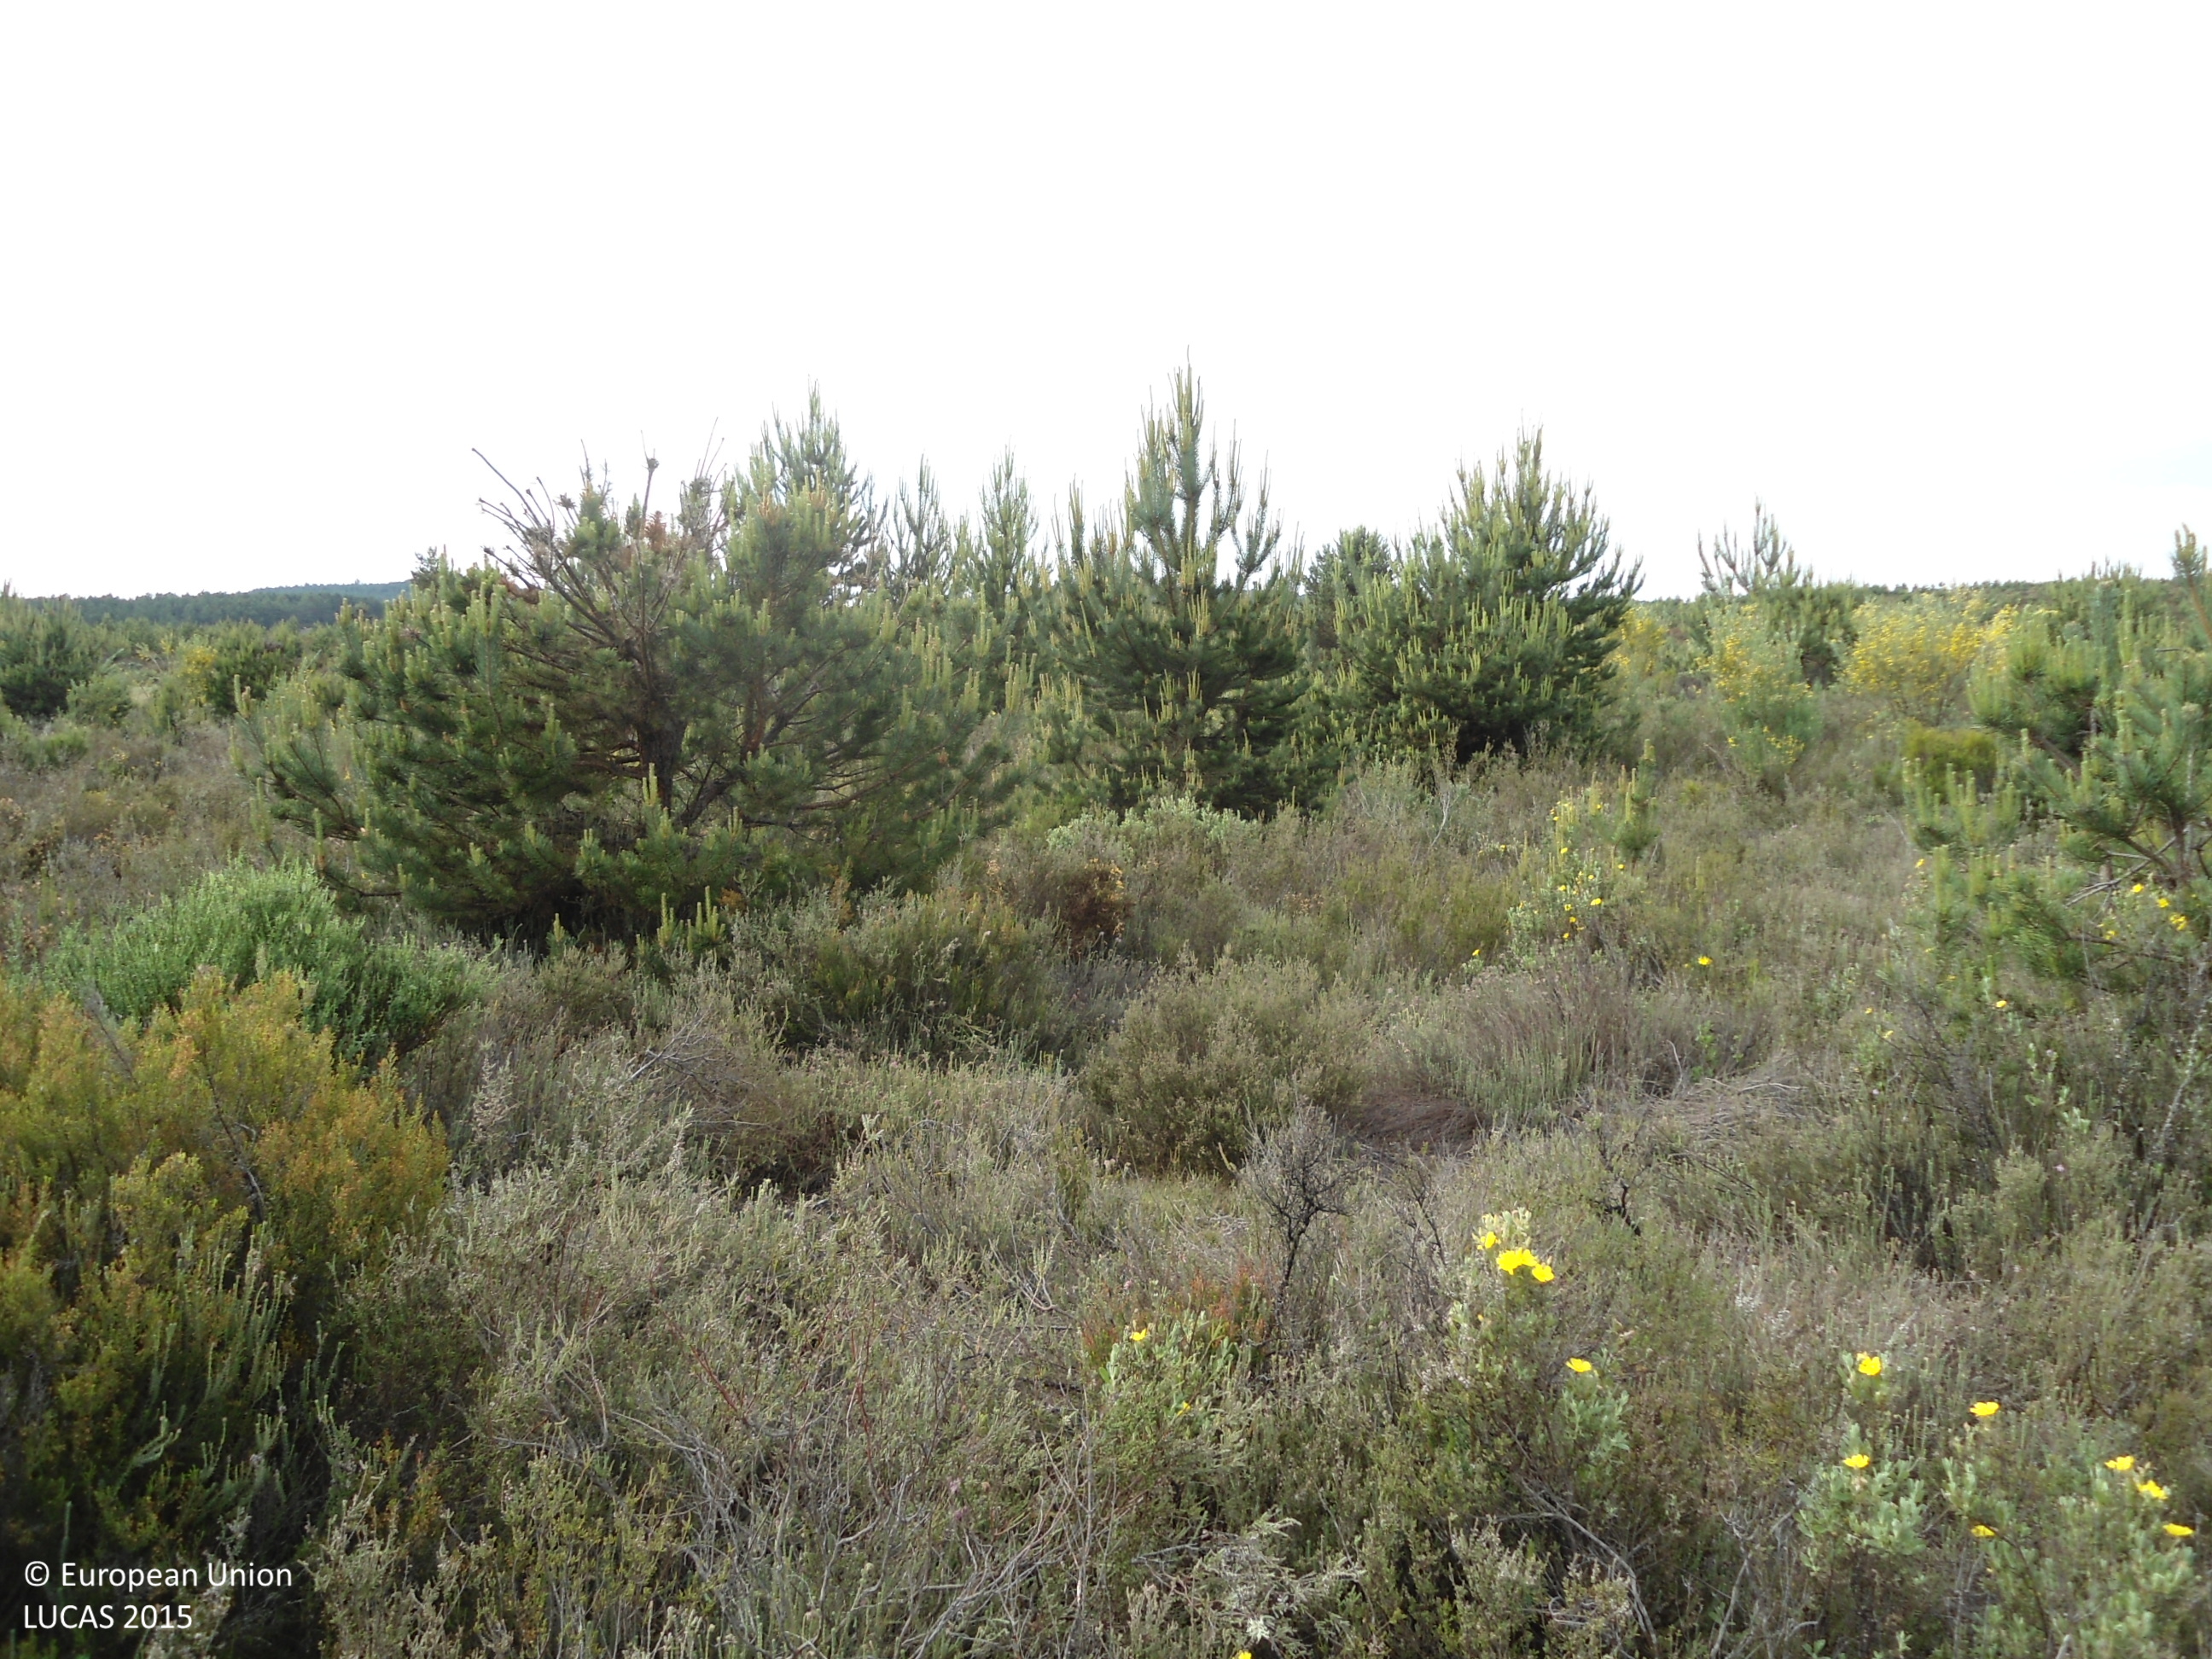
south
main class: Woodland
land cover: Pine dominated coniferous woodland
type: coniferous forest of the mediterranean region
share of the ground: 25 - 50 %
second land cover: Shrubland without tree cover
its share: 50 - 75 %
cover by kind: shrubs 70 %, coniferous forest trees 25 %, herbaceous plants 5 %
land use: Forestry
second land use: Community services
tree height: < 5 m
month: June
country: ES
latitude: 41.9827
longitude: -6.5371
